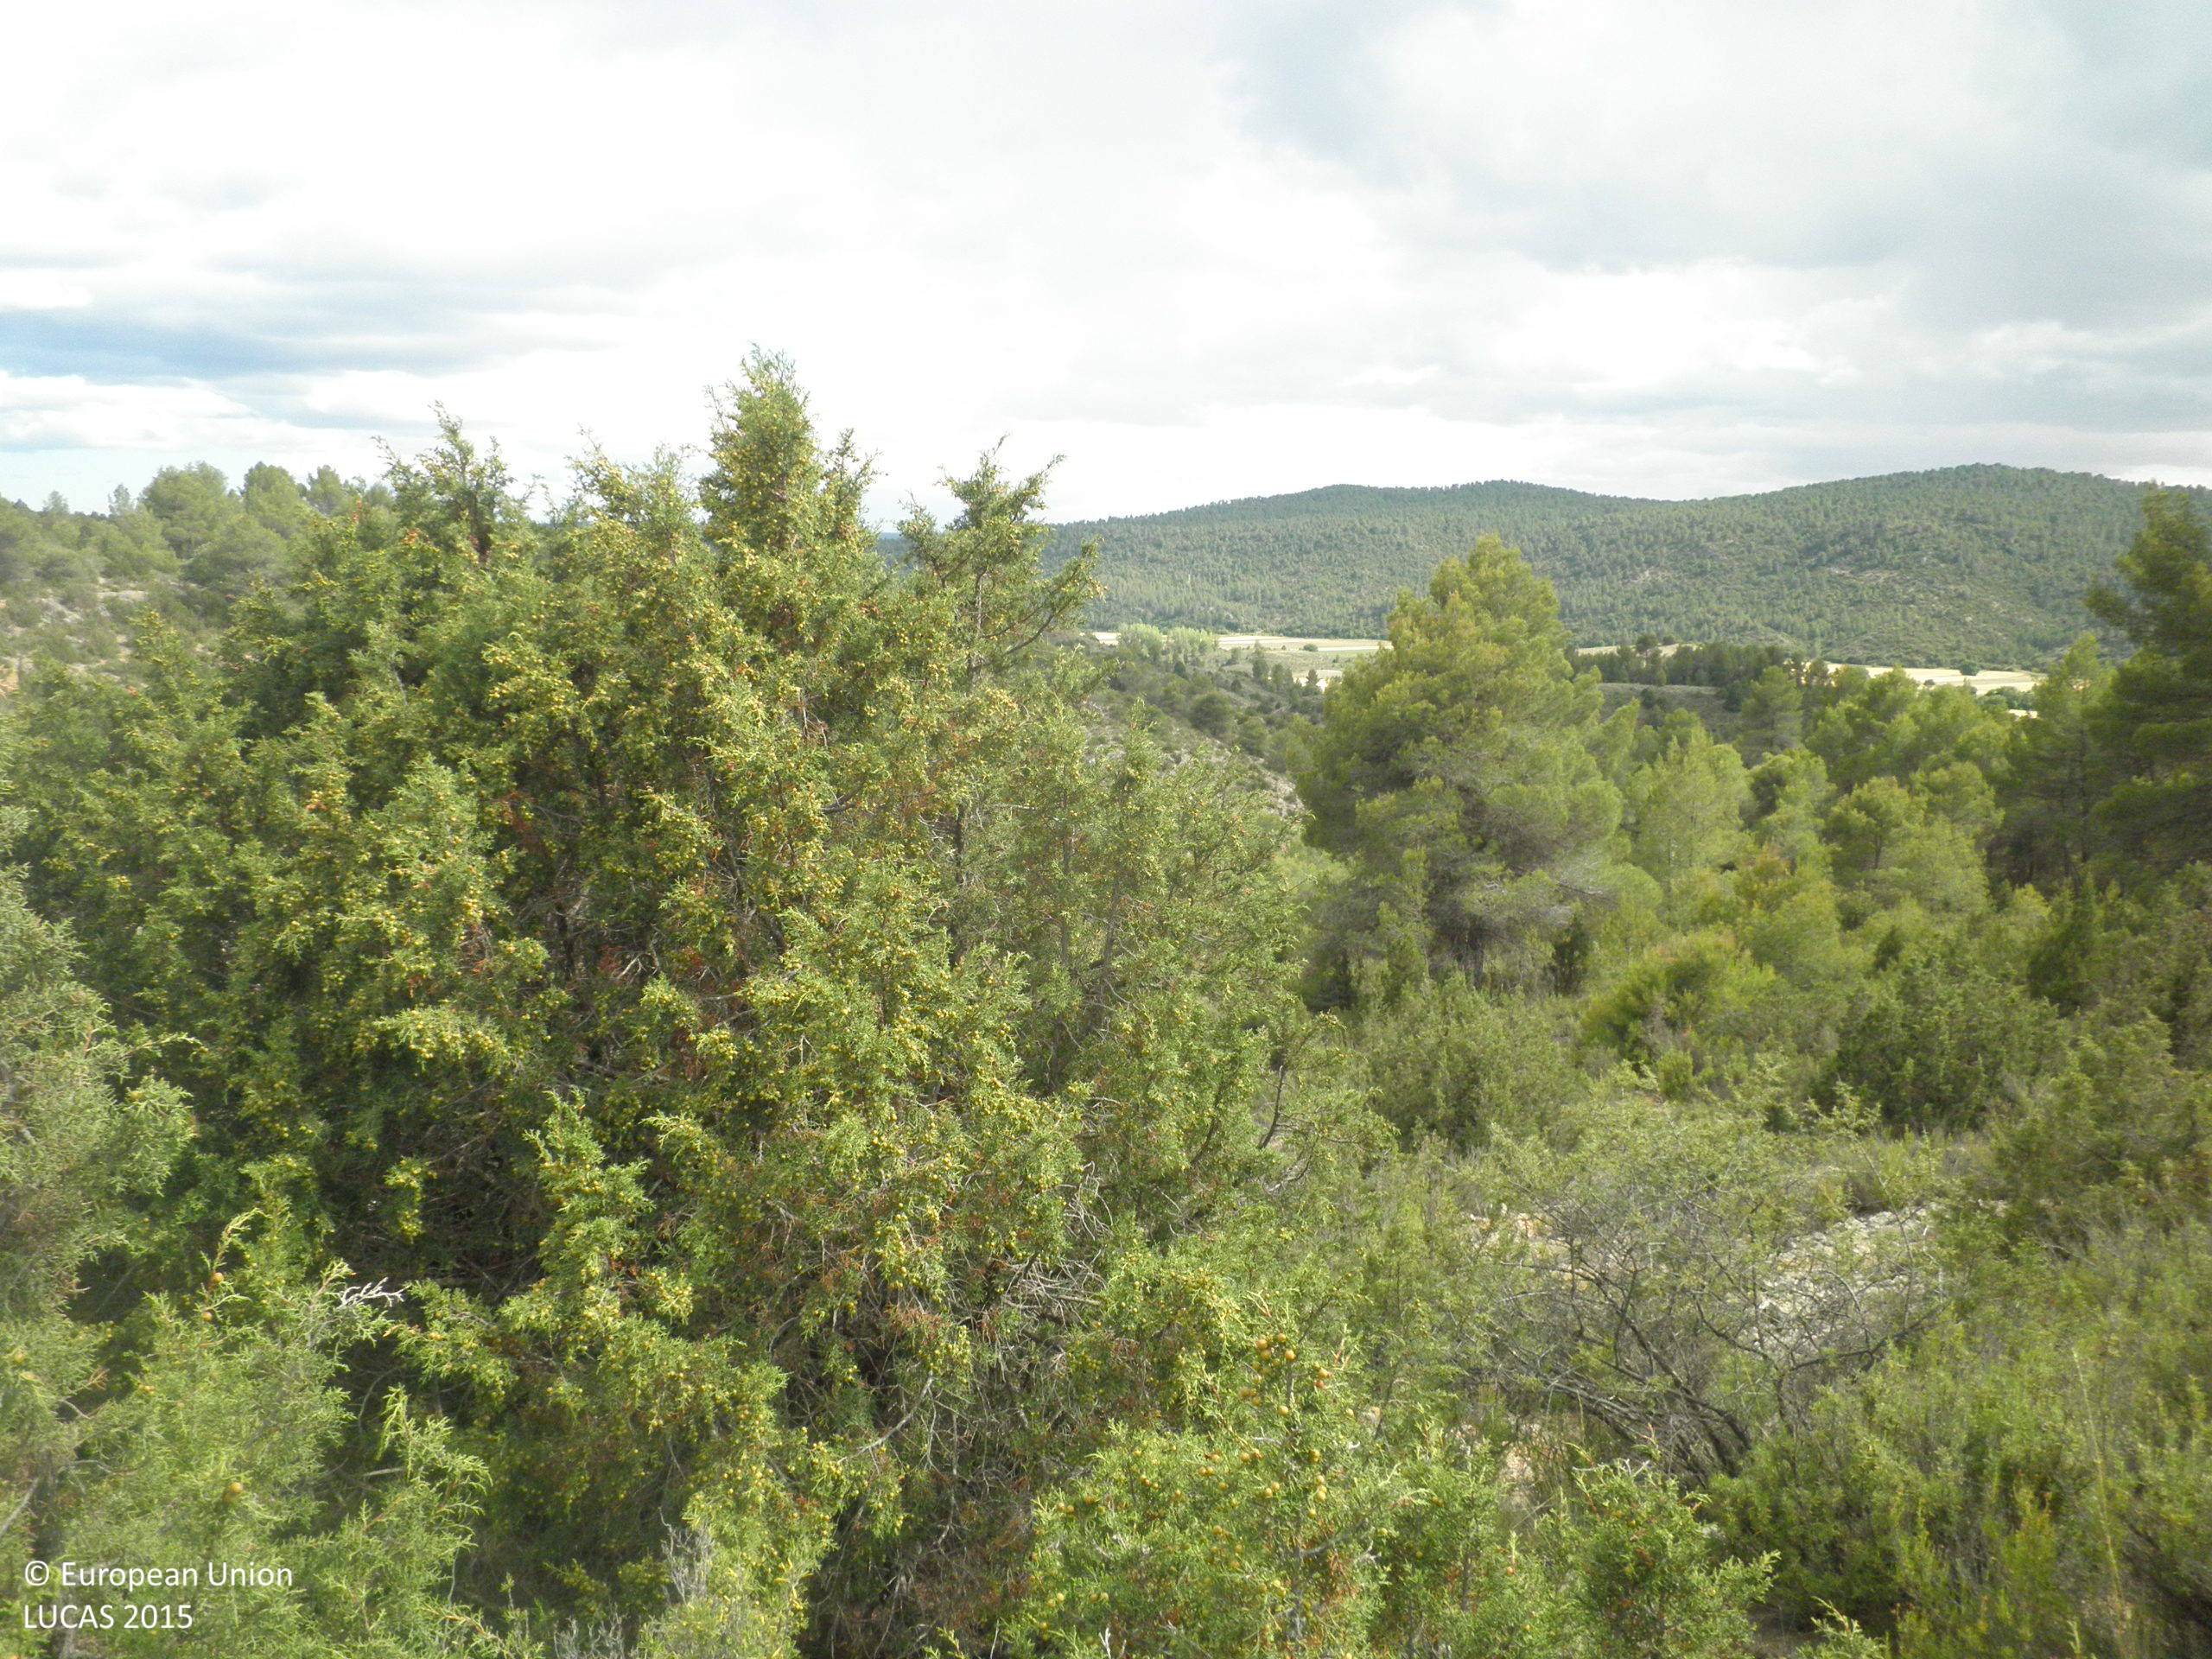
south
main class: Shrubland
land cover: Shrubland without tree cover
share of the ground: 25 - 50 %
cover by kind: unconsolidated bare surface 60 %, shrubs 30 %, herbaceous plants 10 %
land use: Semi-natural and natural areas not in use
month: June
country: ES
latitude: 39.7636
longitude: -1.7168
